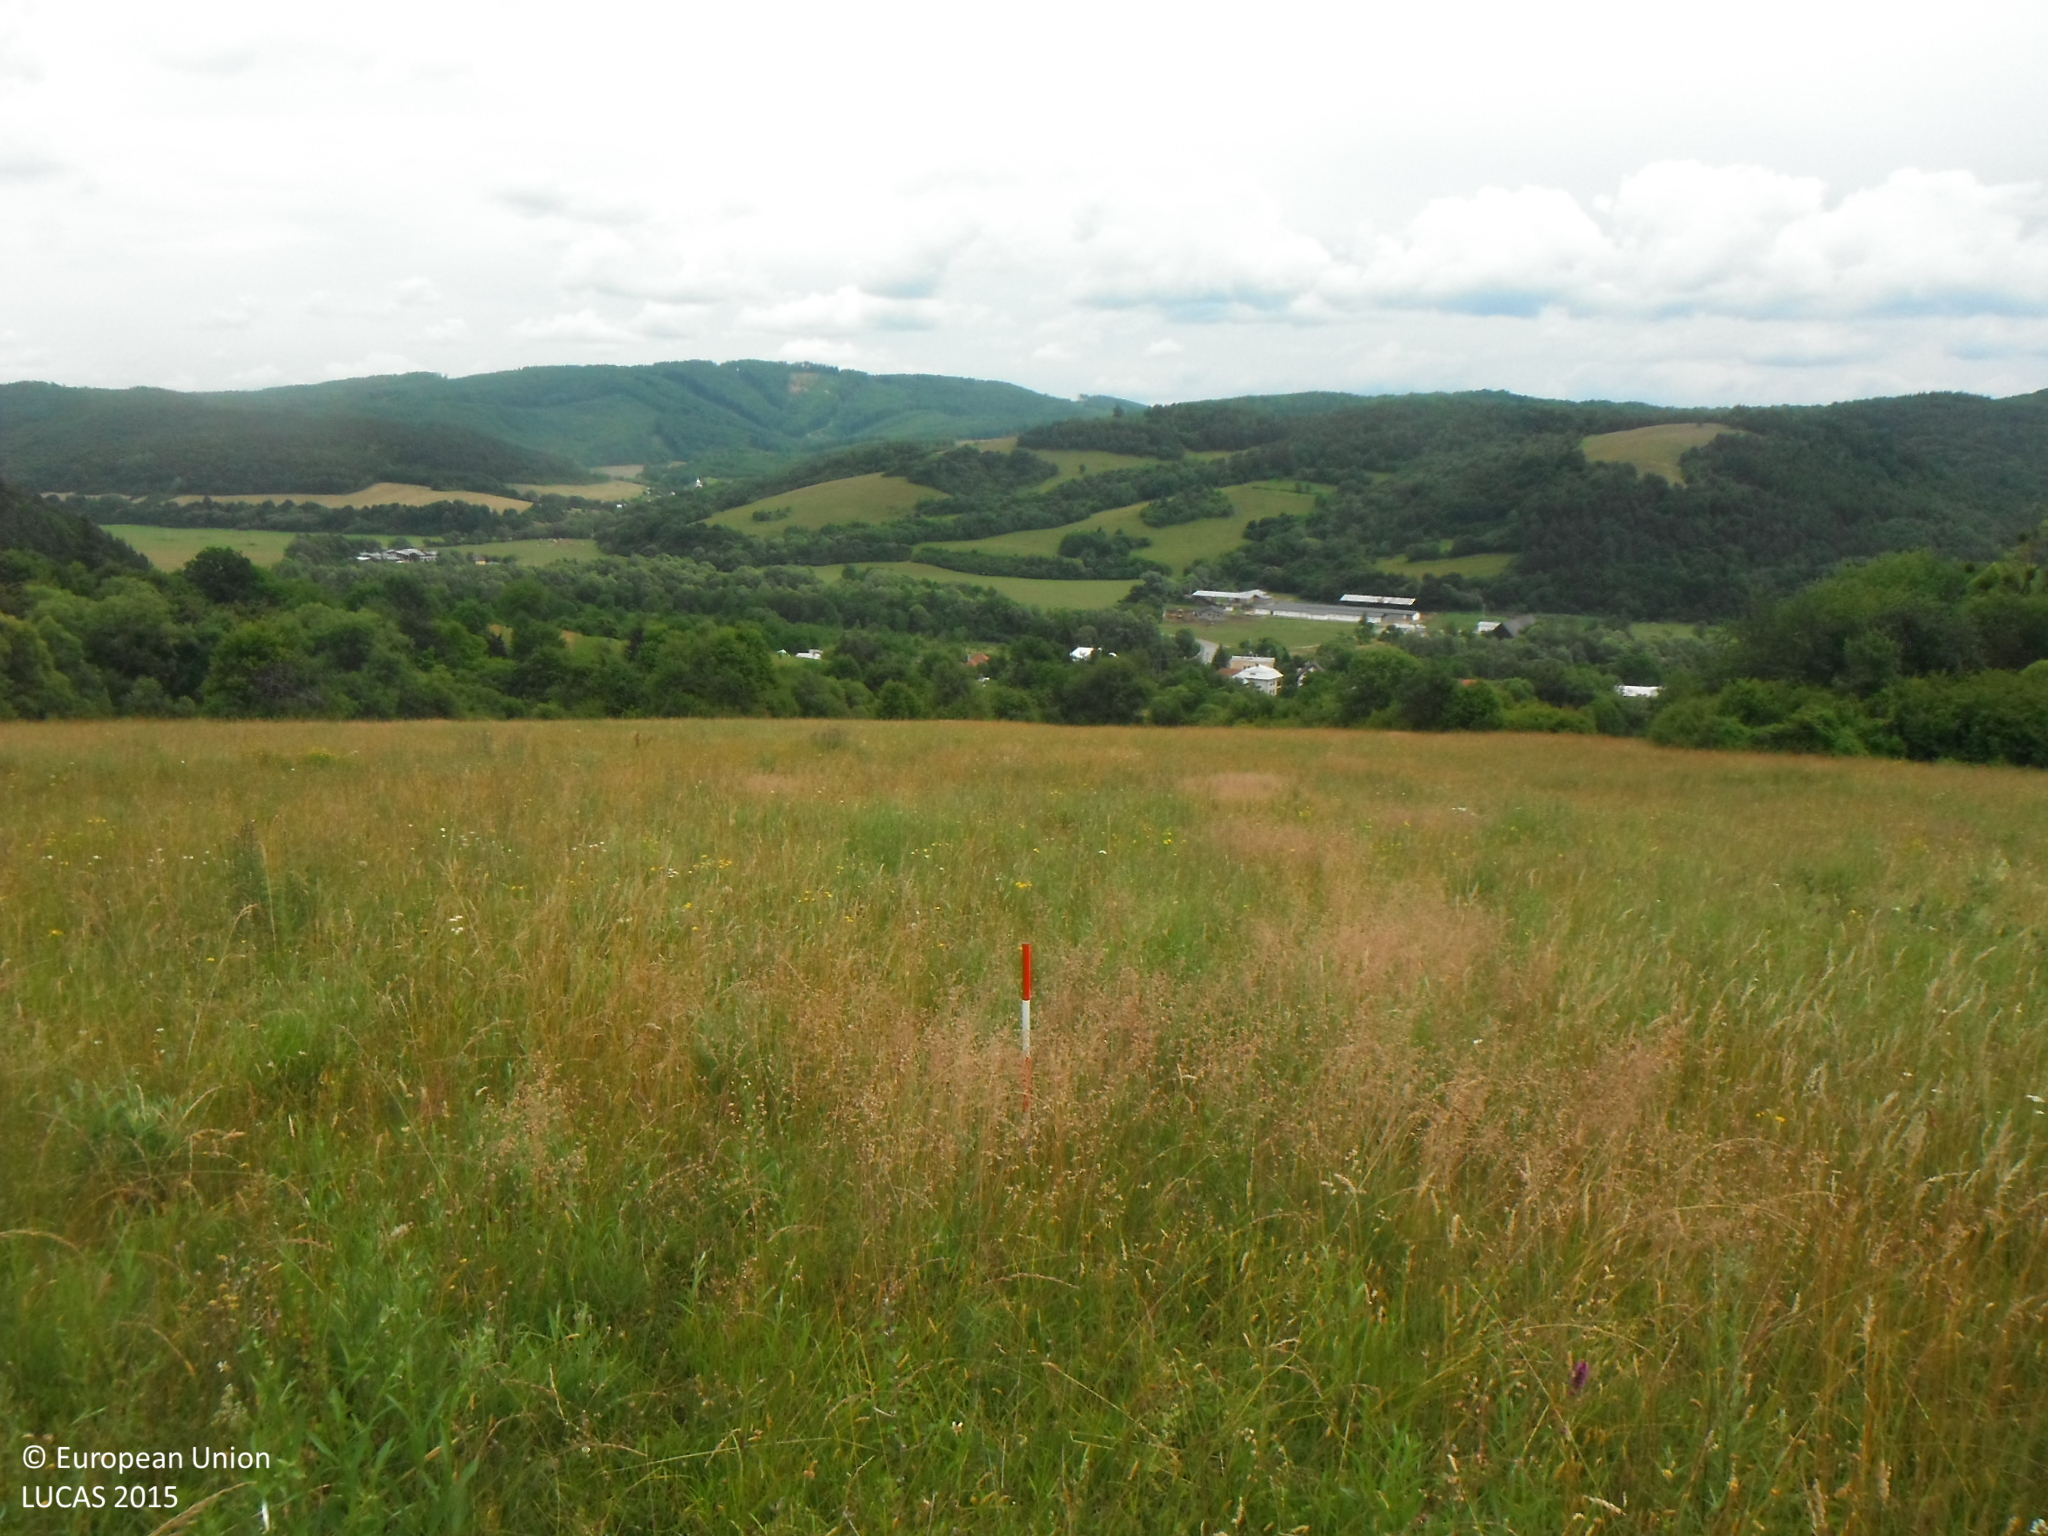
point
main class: Grassland
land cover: Grassland without tree/shrub cover
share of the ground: > 75 %
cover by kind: herbaceous plants 100 %
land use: Agriculture (excluding fallow land and kitchen gardens)
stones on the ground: < 10 %
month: June
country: SK
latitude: 49.0269
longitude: 21.9393
